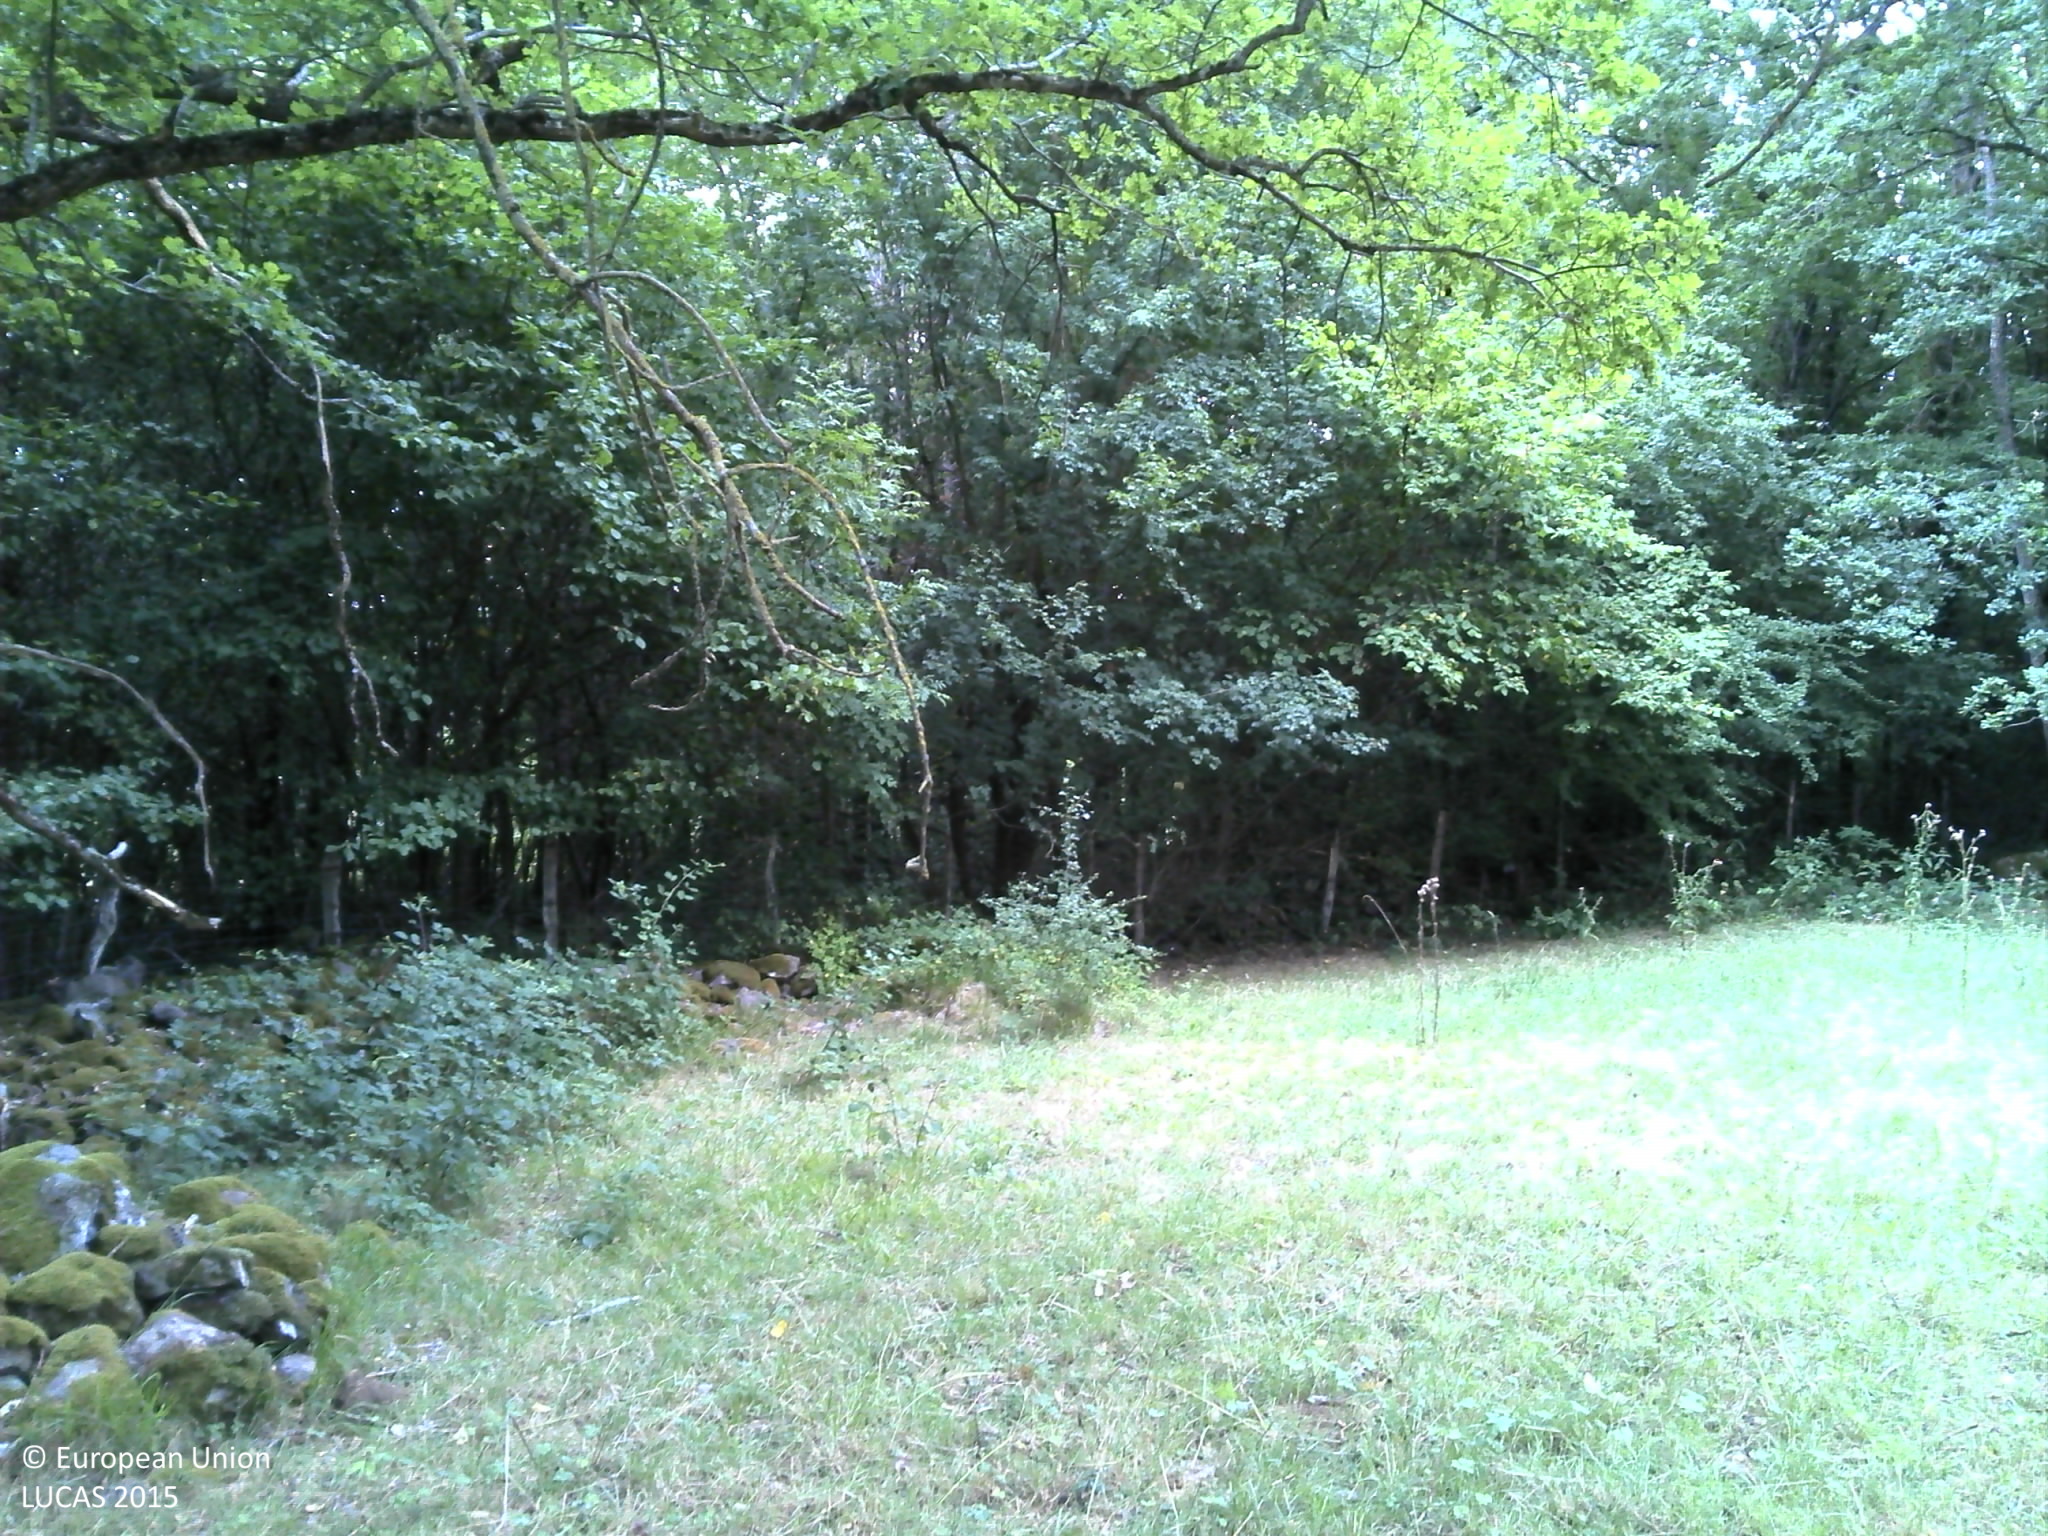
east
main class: Woodland
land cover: Broadleaved woodland
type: mesophytic deciduous forest
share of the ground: 25 - 50 %
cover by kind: herbaceous plants 50 %, broadleaved forest trees 40 %, shrubs 10 %
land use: Forestry
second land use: Agriculture (excluding fallow land and kitchen gardens)
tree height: > 5 m
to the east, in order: Broadleaved woodland; Grass margins; Paved roads, cycling and walking lanes; Grass margins; Fences; Single bushes/trees; Grassland without tree/shrub cover; Broadleaved woodland; Grassland without tree/shrub cover; Broadleaved woodland; Grassland with sparse tree/shrub cover
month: July
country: FR
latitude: 45.6736
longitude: 3.3383
